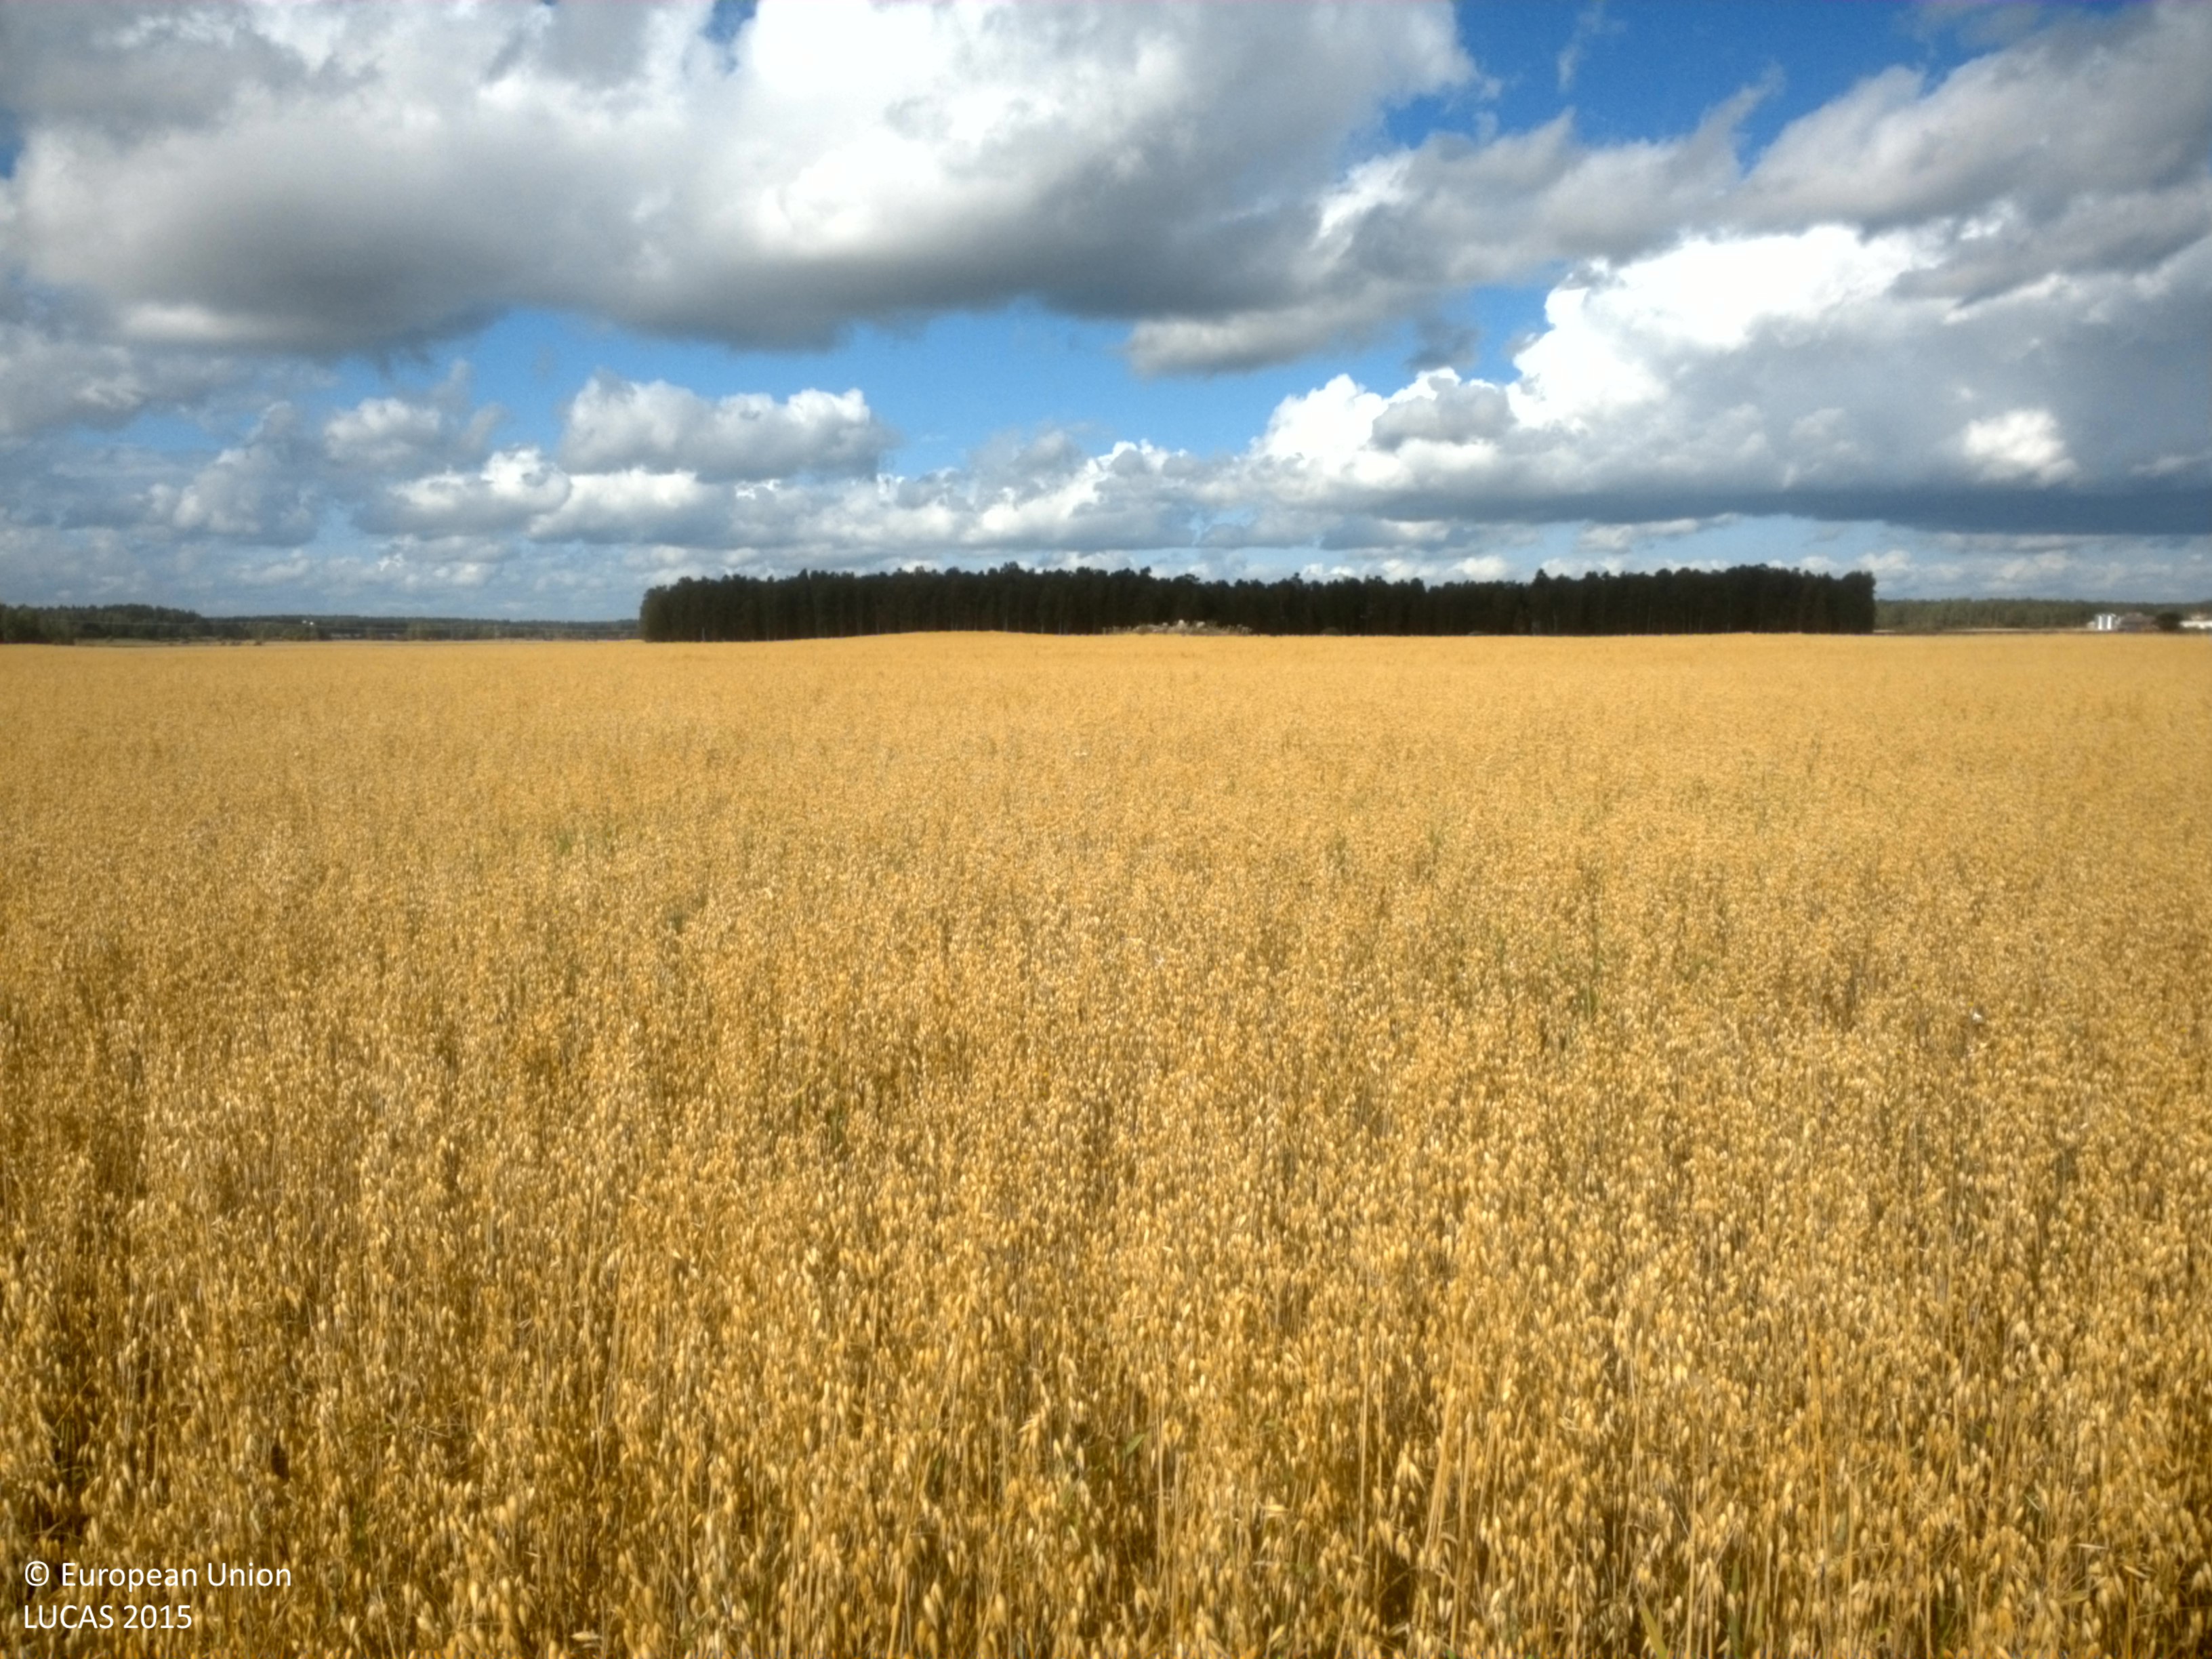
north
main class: Cropland
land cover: Oats
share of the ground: > 75 %
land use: Agriculture (excluding fallow land and kitchen gardens)
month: August
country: SE
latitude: 59.4702
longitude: 15.6919
